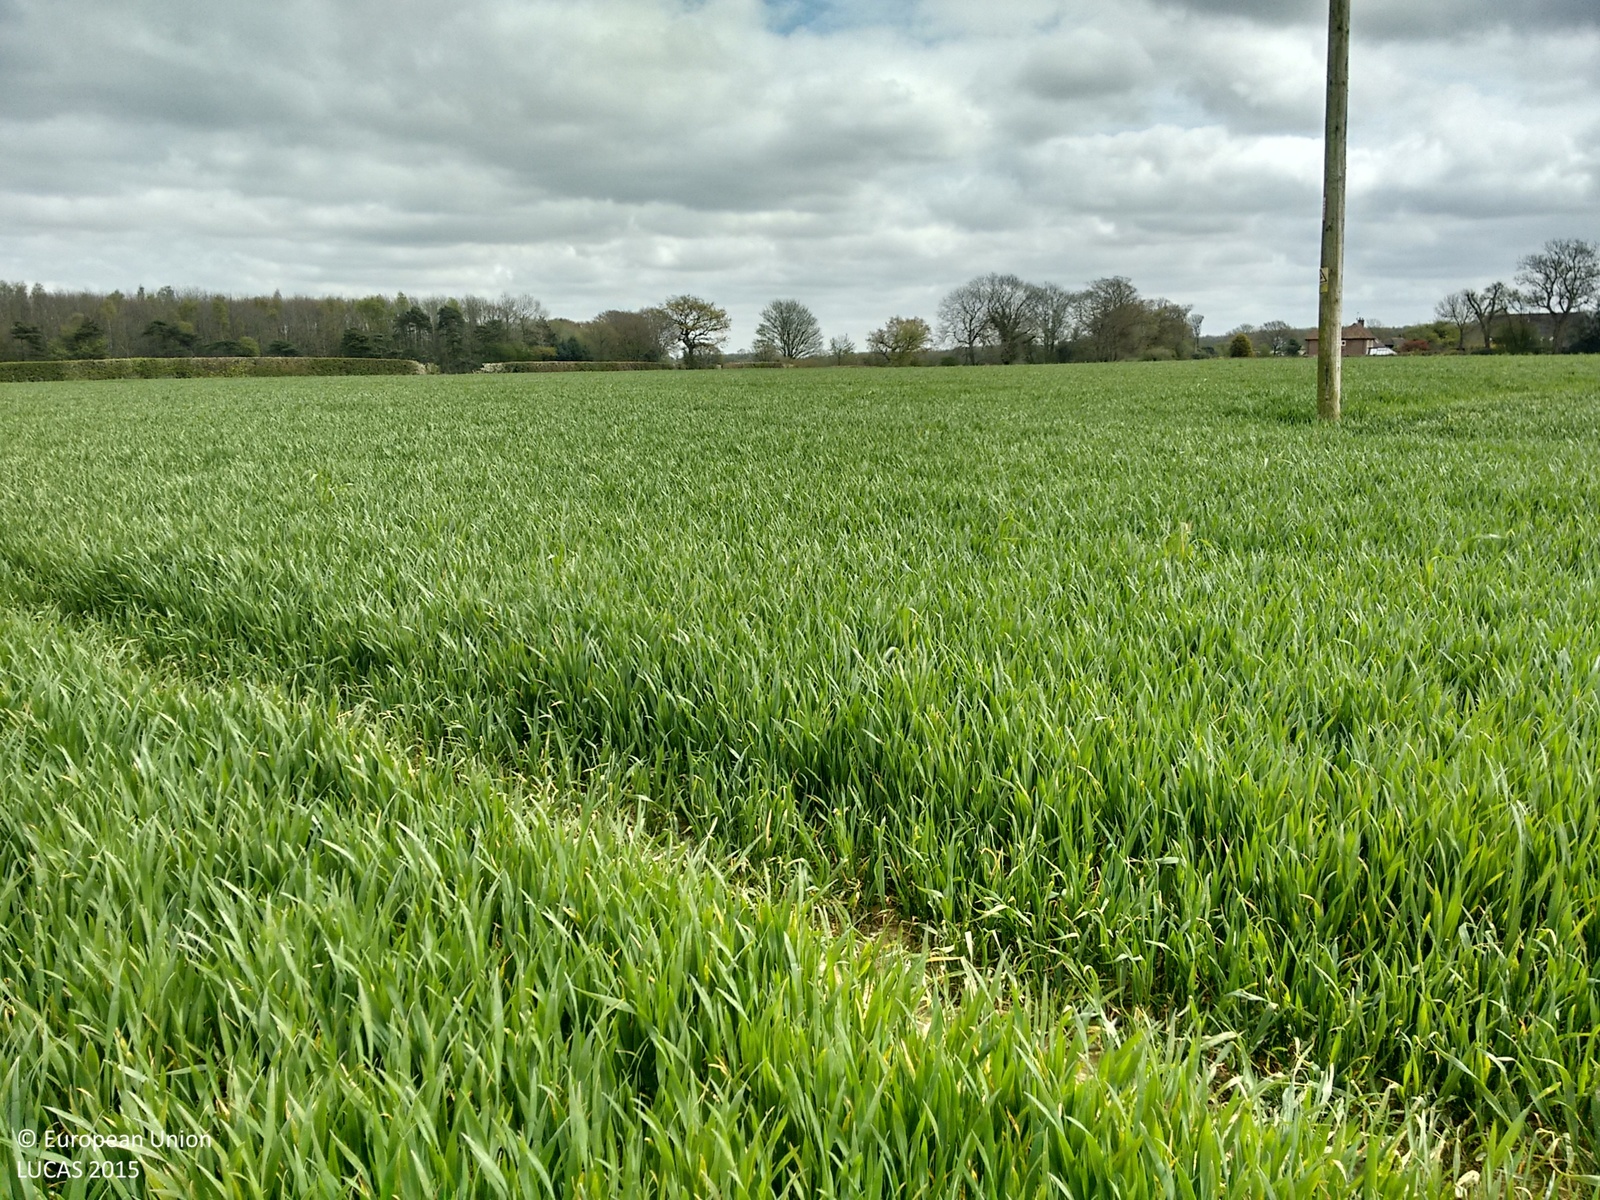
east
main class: Cropland
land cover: Common wheat
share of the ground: > 75 %
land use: Agriculture (excluding fallow land and kitchen gardens)
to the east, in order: Common wheat; Electric lines; Common wheat; Grass margins; Paved roads, cycling and walking lanes; Grass margins; Managed hedges; Common wheat
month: May
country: GB
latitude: 51.2386
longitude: 0.7646
